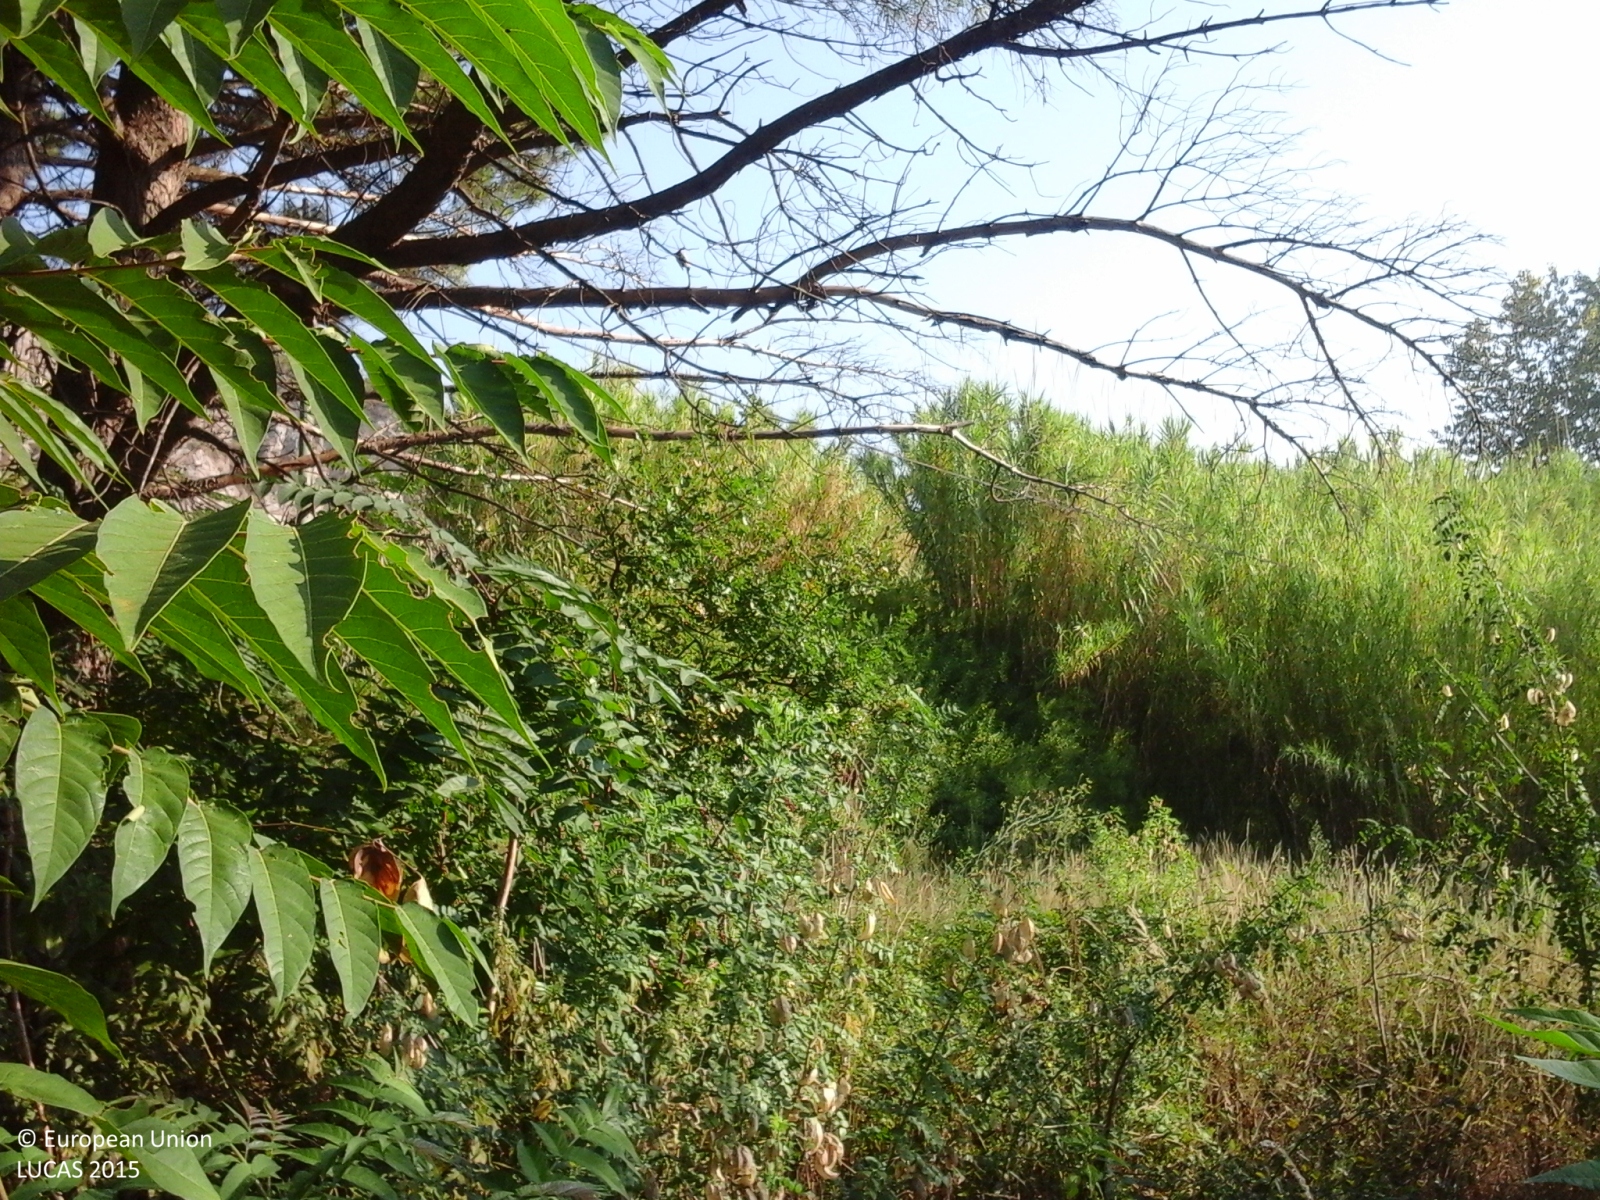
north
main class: Shrubland
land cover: Shrubland with sparse tree cover
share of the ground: > 75 %
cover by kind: shrubs 50 %, herbaceous plants 30 %, broadleaved forest trees 5 %
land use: Semi-natural and natural areas not in use
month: September
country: IT
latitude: 40.7727
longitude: 14.6607
